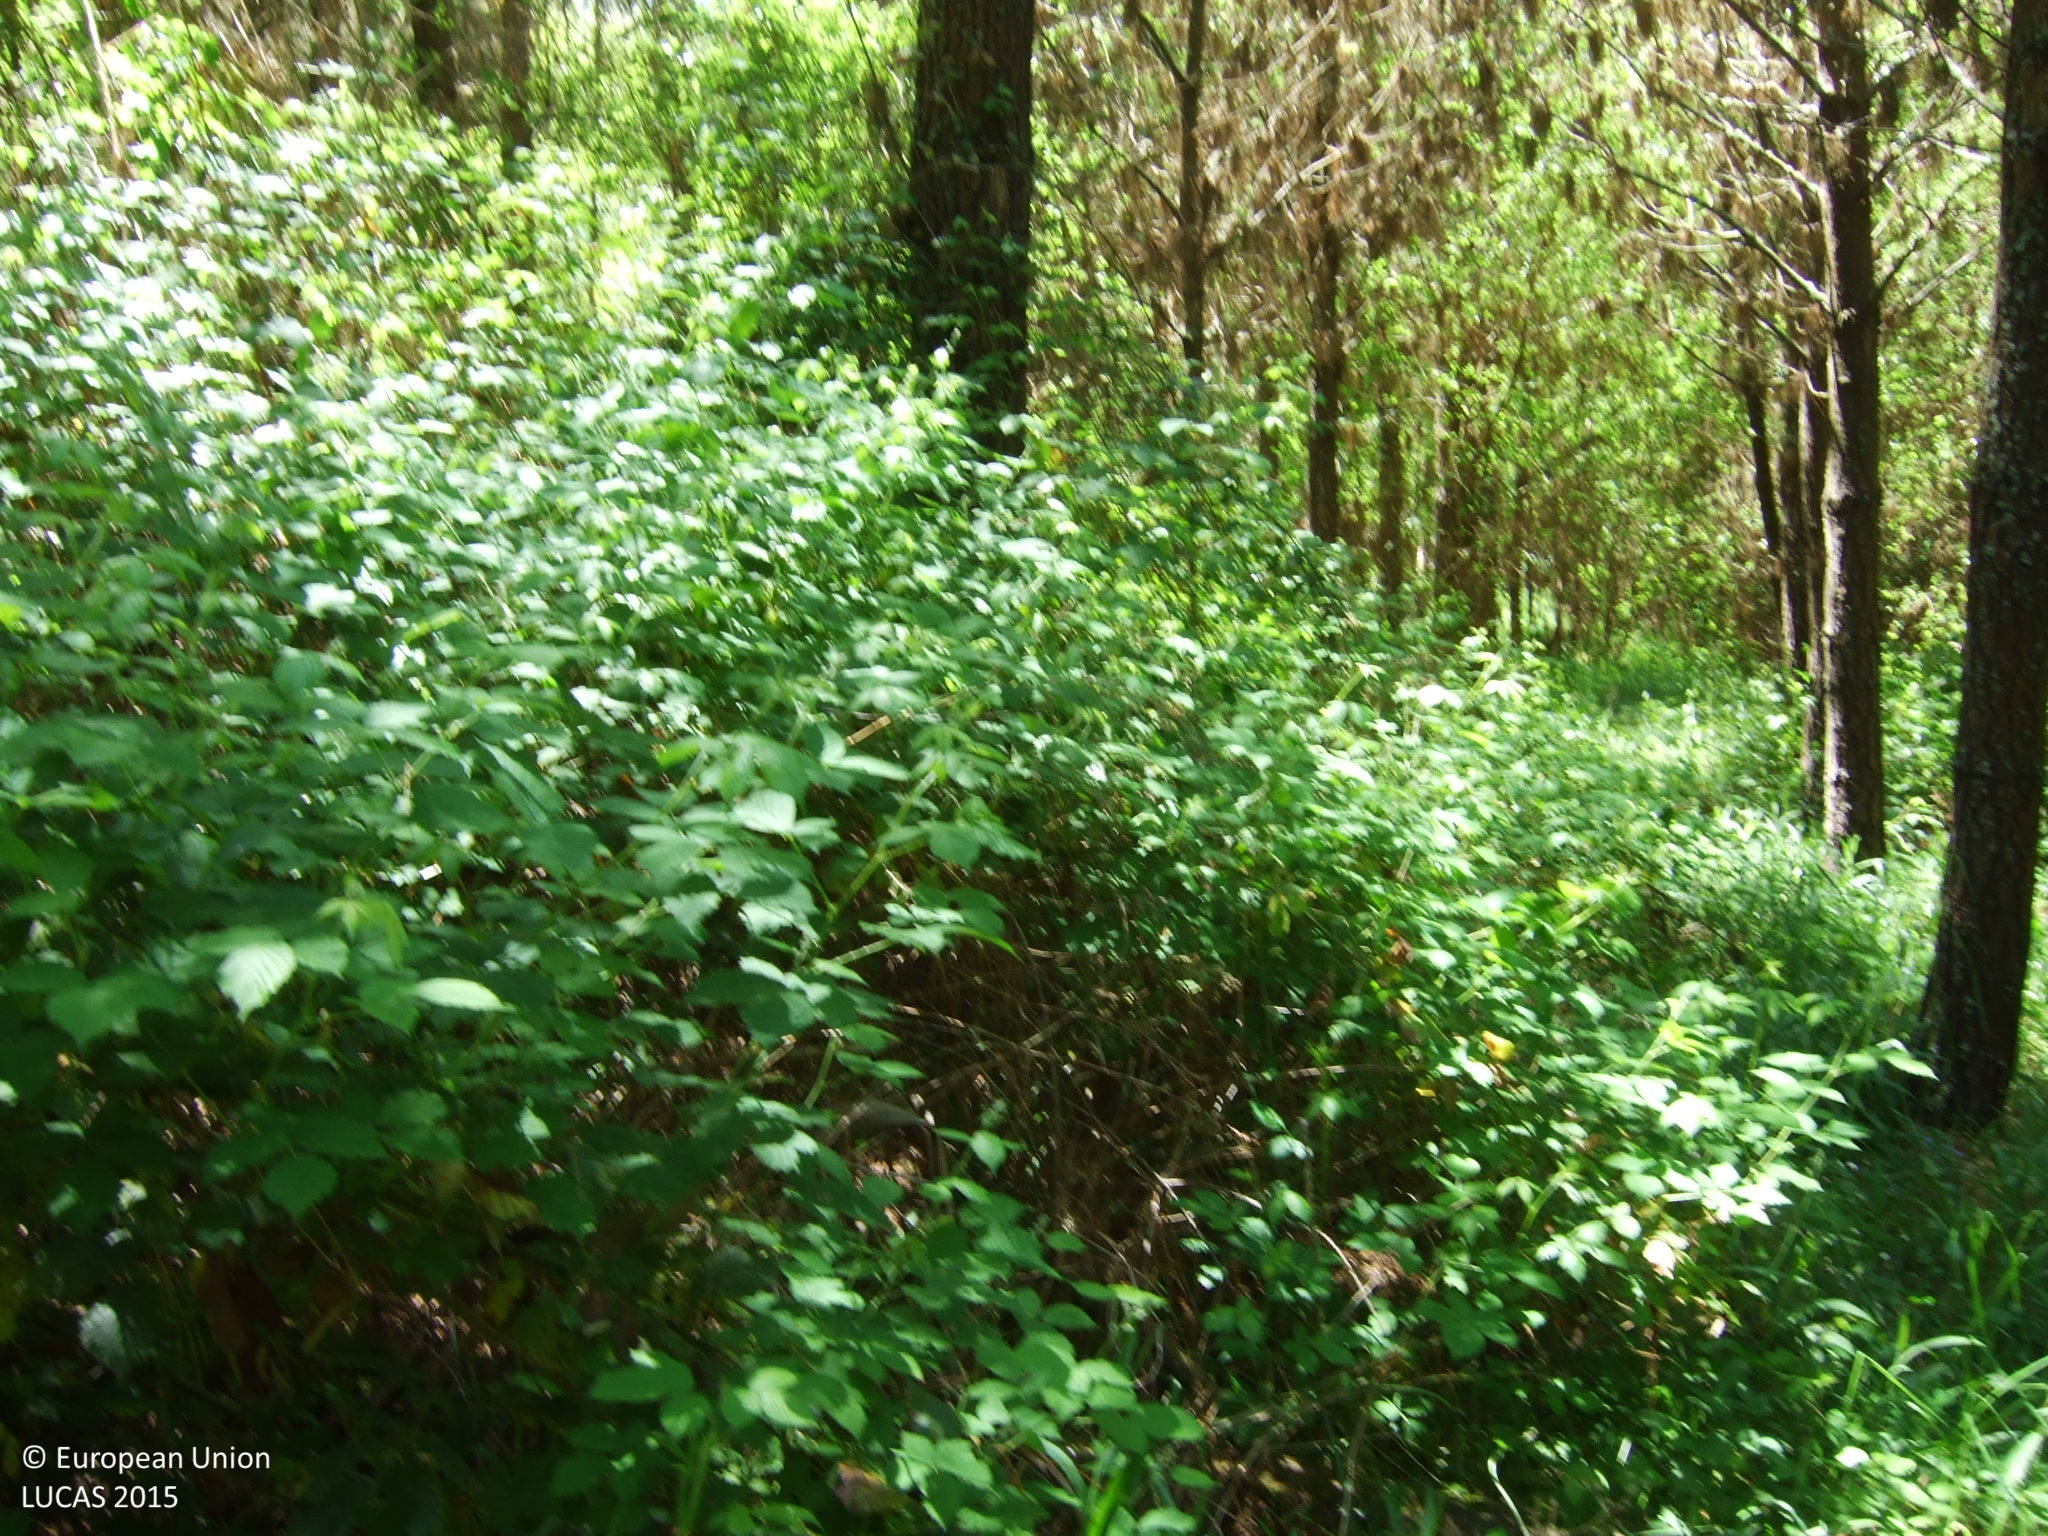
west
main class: Woodland
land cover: Pine dominated mixed woodland
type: exotic forest
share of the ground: 50 - 75 %
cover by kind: coniferous forest trees 40 %, broadleaved forest trees 30 %, shrubs 30 %
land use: Forestry
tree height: > 5 m
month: May
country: ES
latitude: 43.2629
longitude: -7.6631
